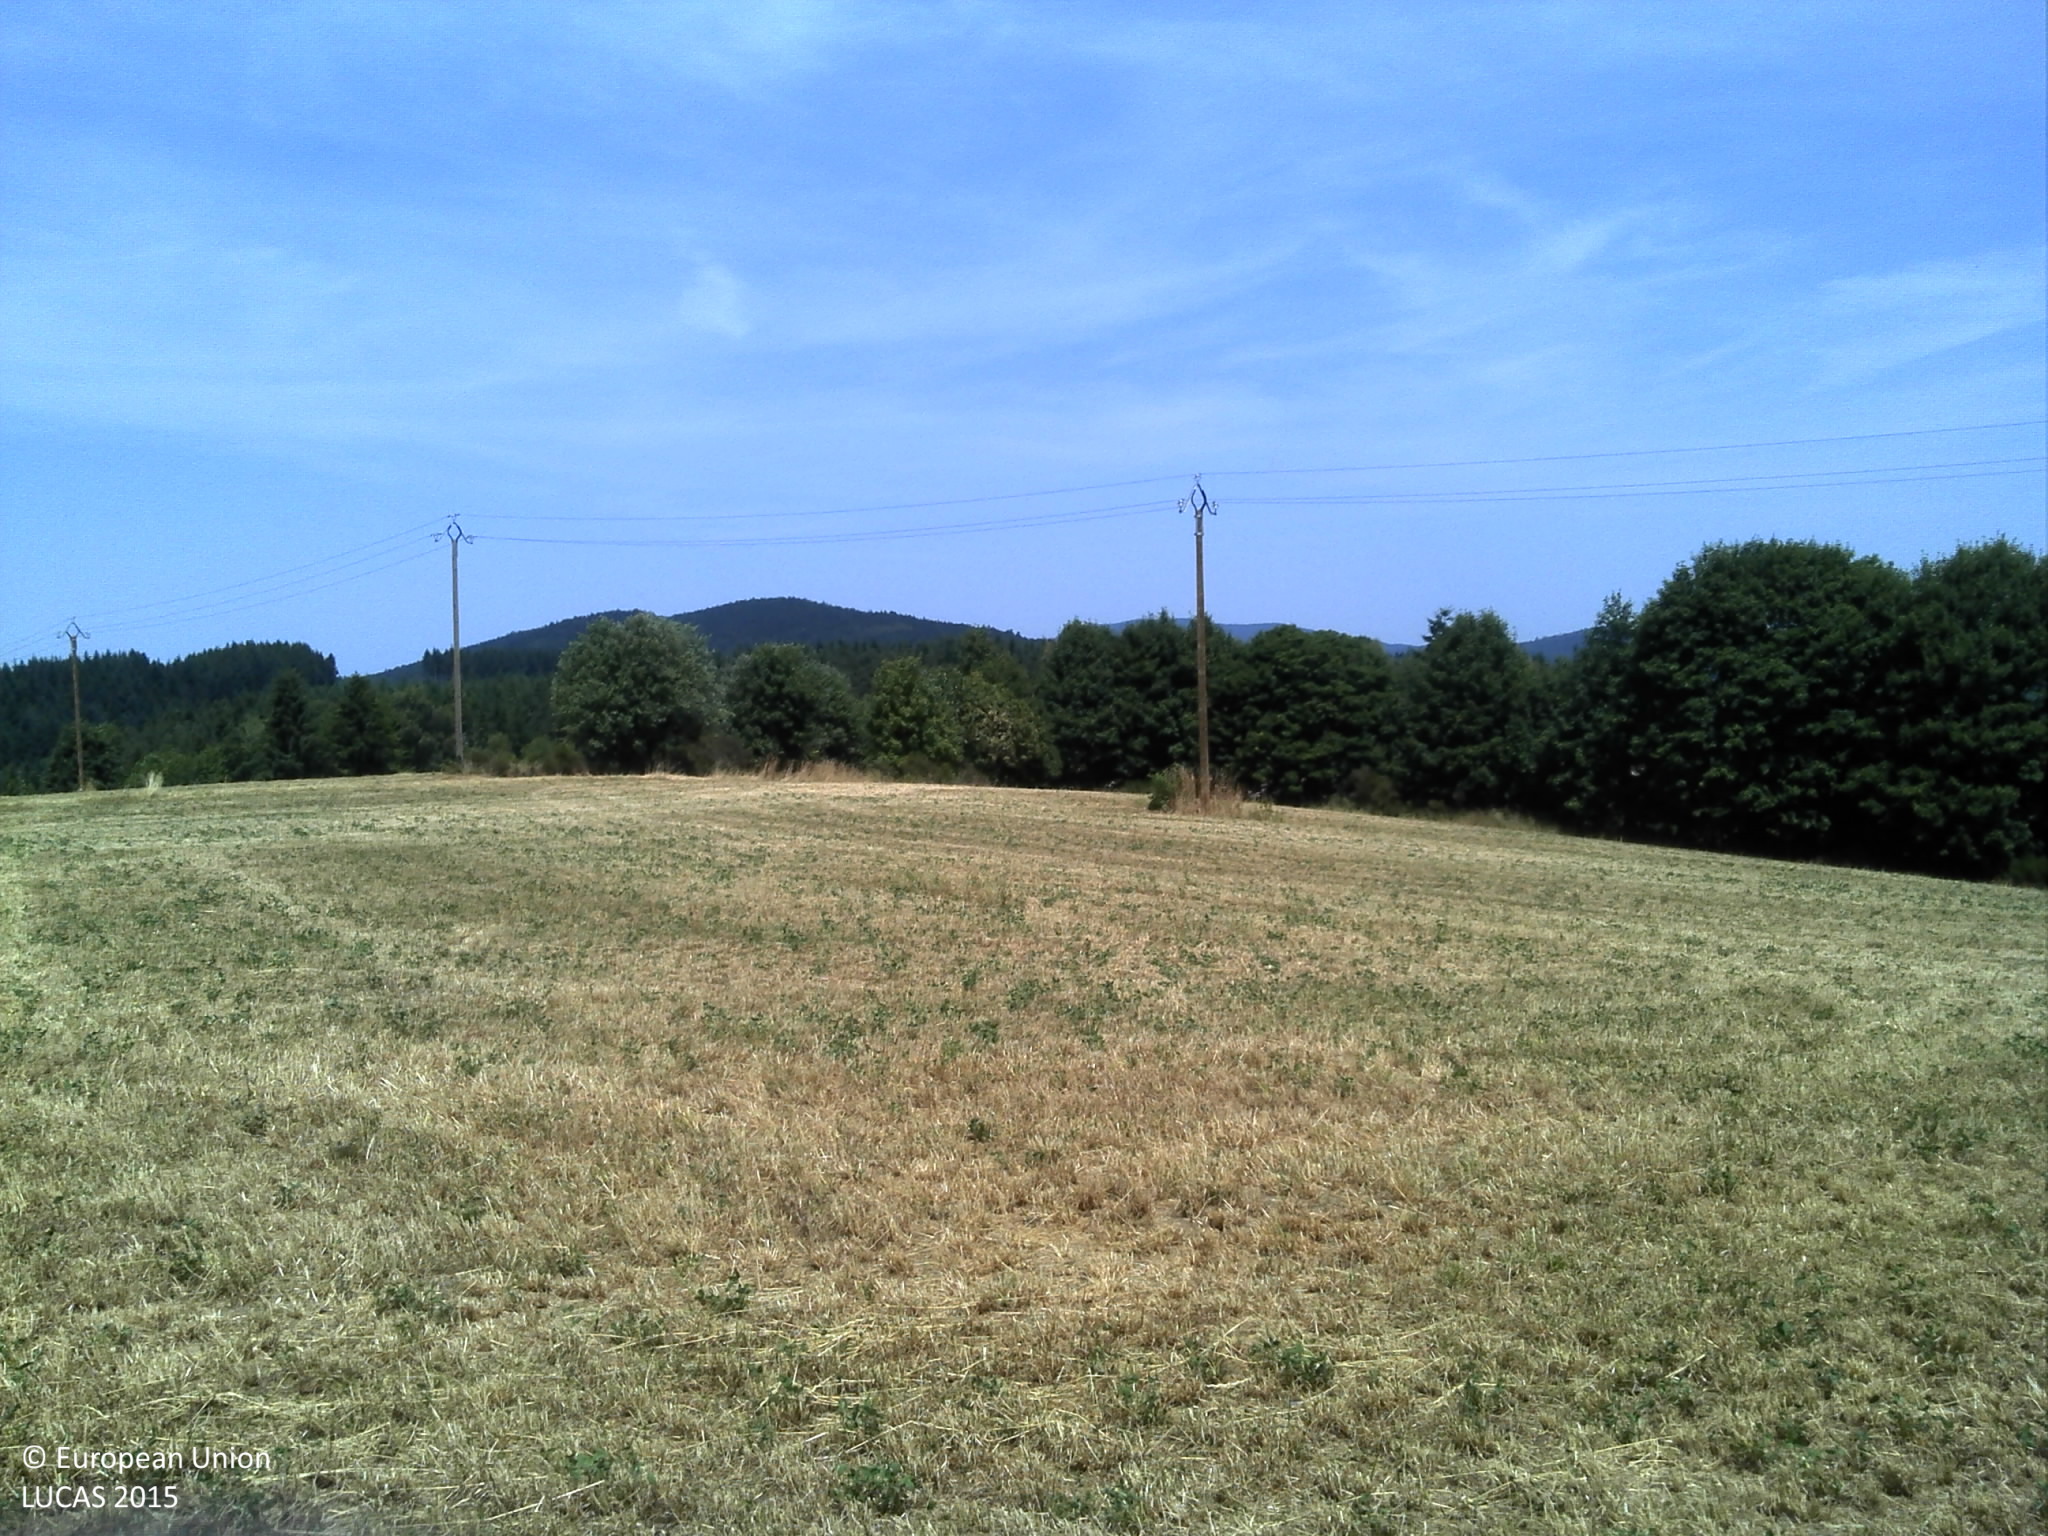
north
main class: Cropland
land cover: Temporary grasslands
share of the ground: > 75 %
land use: Agriculture (excluding fallow land and kitchen gardens)
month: July
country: FR
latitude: 45.8062
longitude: 3.7350
